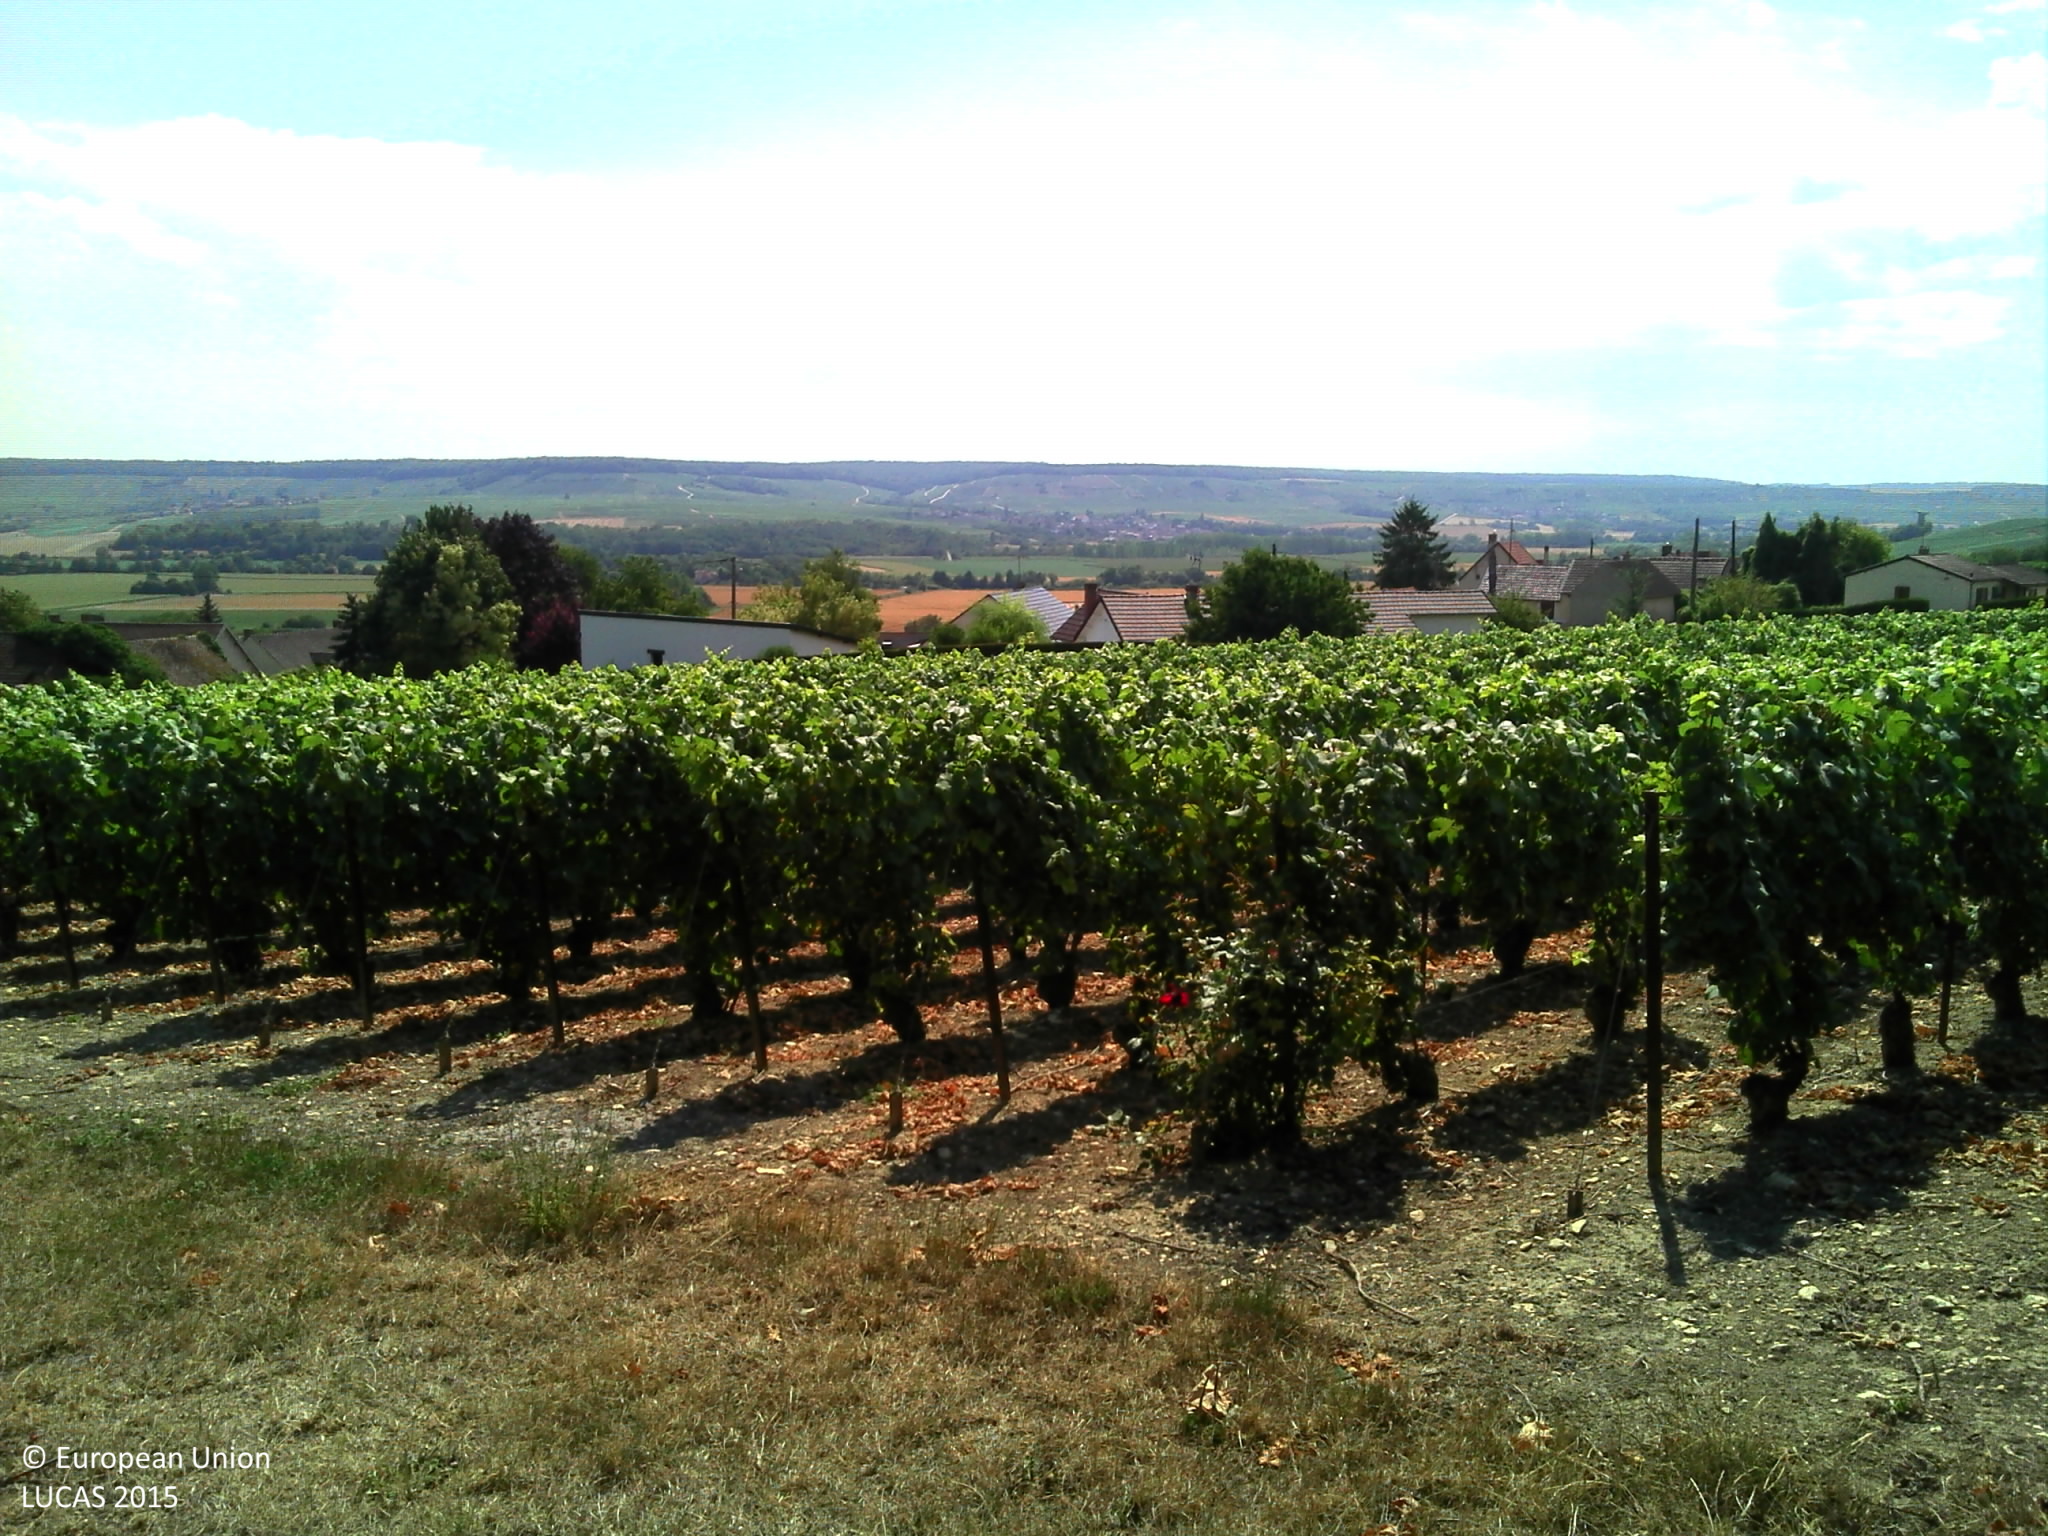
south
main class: Grassland
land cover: Grassland without tree/shrub cover
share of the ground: > 75 %
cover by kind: herbaceous plants 85 %, consolidated bare surface 5 %, unconsolidated bare surface 5 %
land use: Semi-natural and natural areas not in use
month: August
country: FR
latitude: 49.1099
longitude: 3.7336
